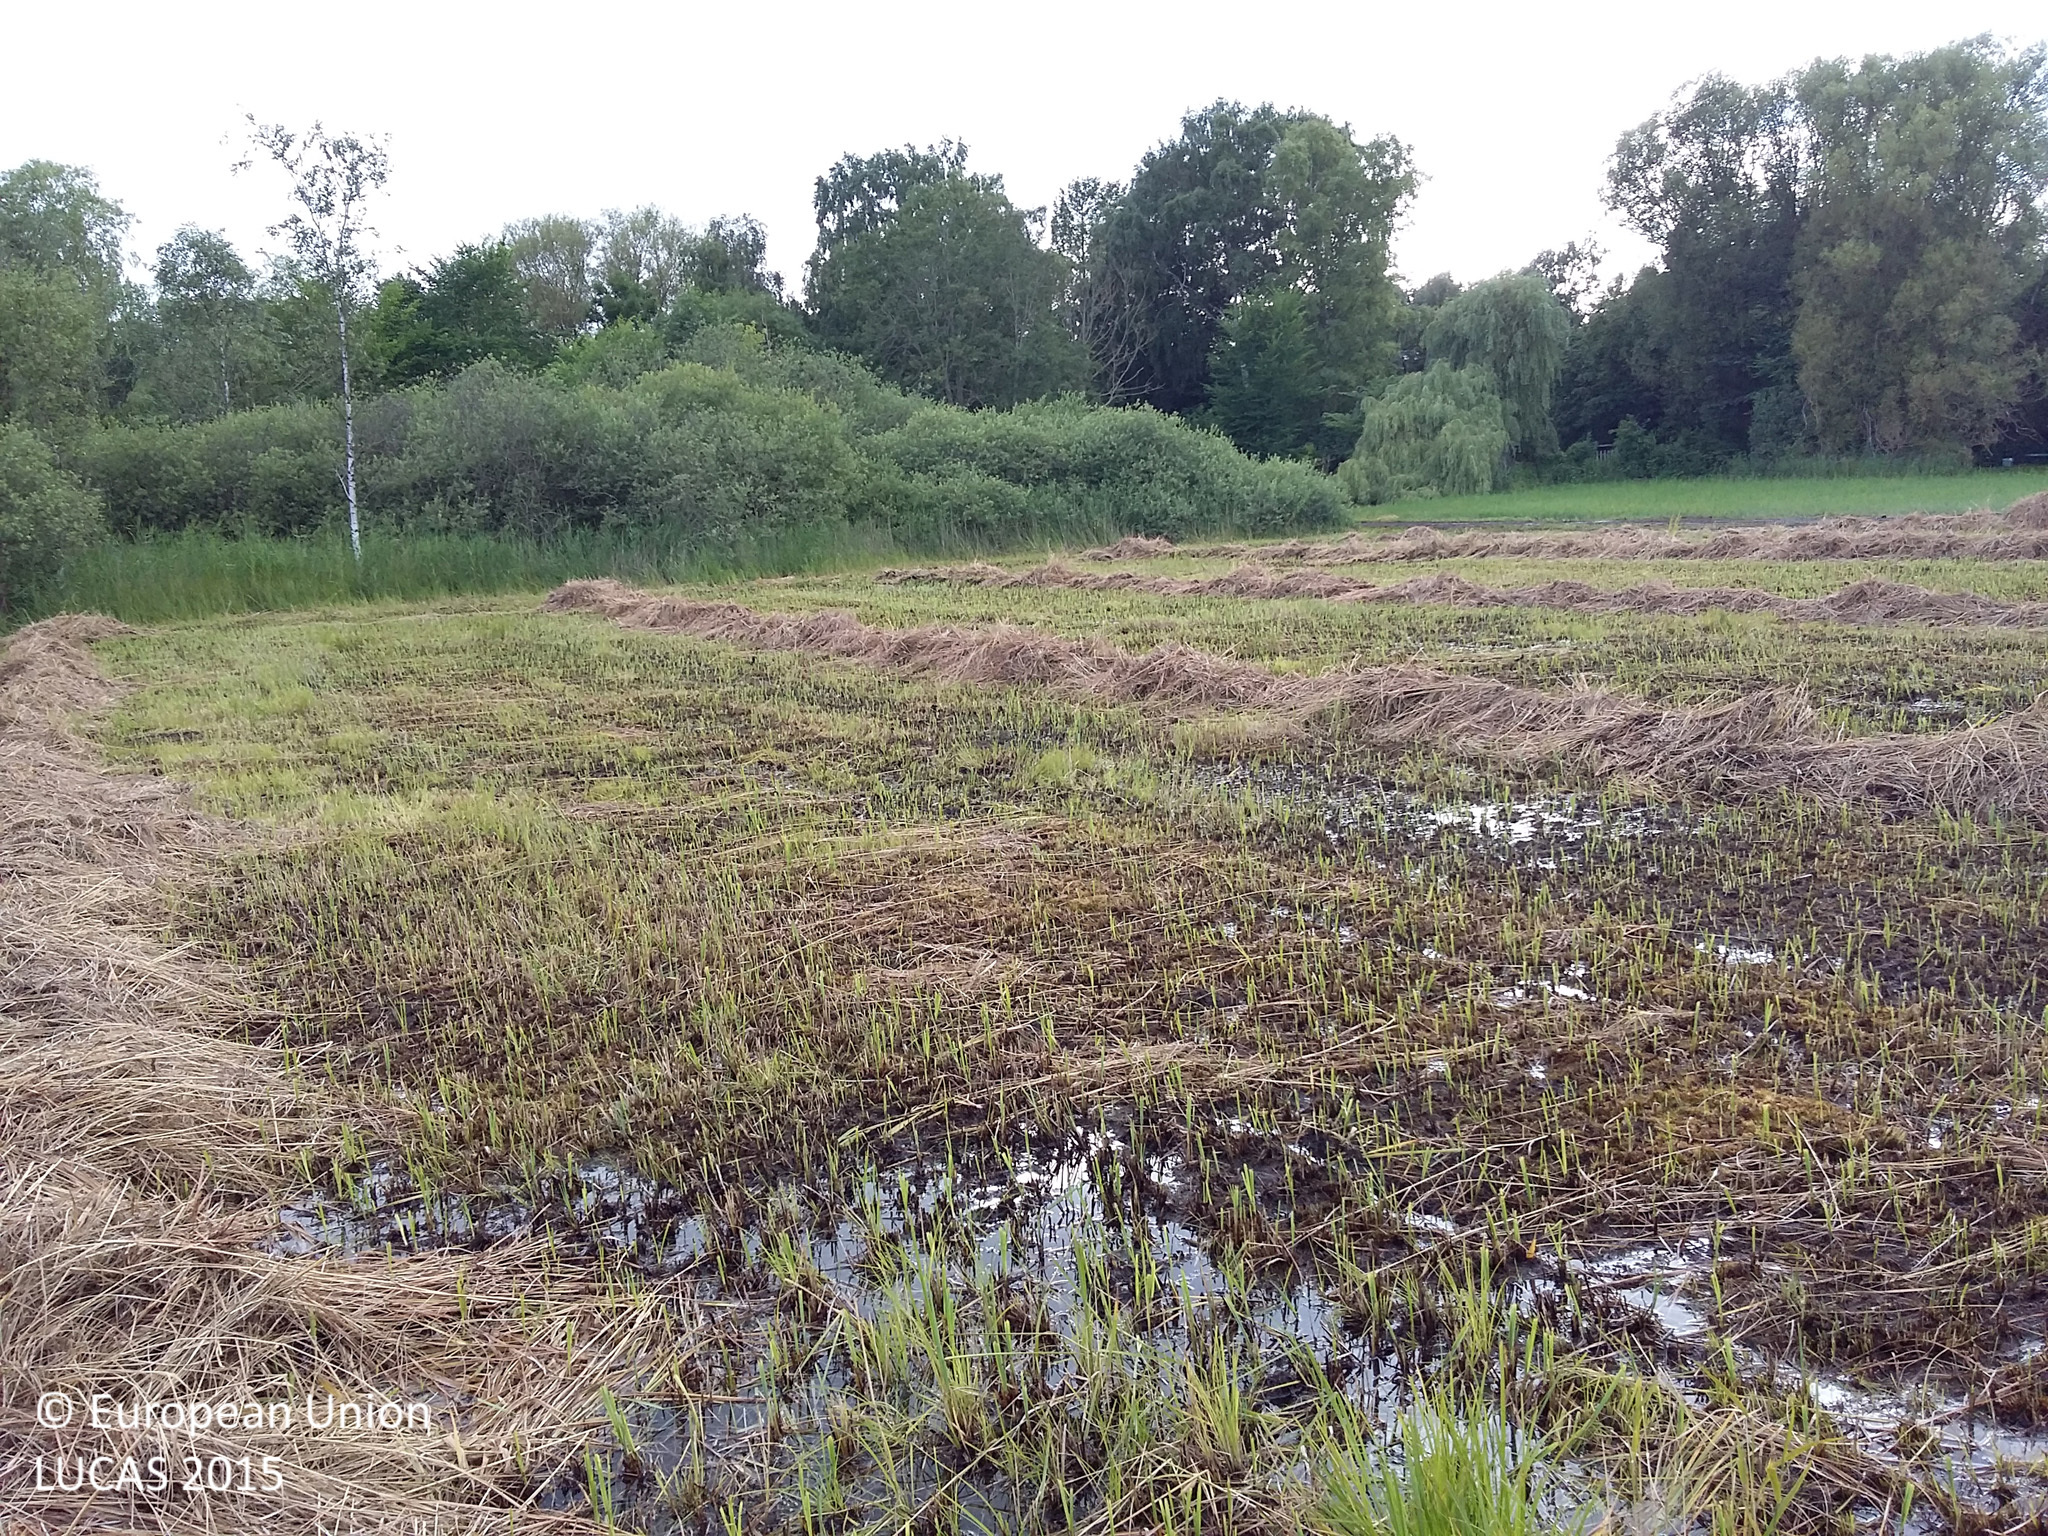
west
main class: Cropland
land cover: Permanent industrial crops
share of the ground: 10 - 25 %
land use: Agriculture (excluding fallow land and kitchen gardens)
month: July
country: DK
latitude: 55.7492
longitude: 12.5311
